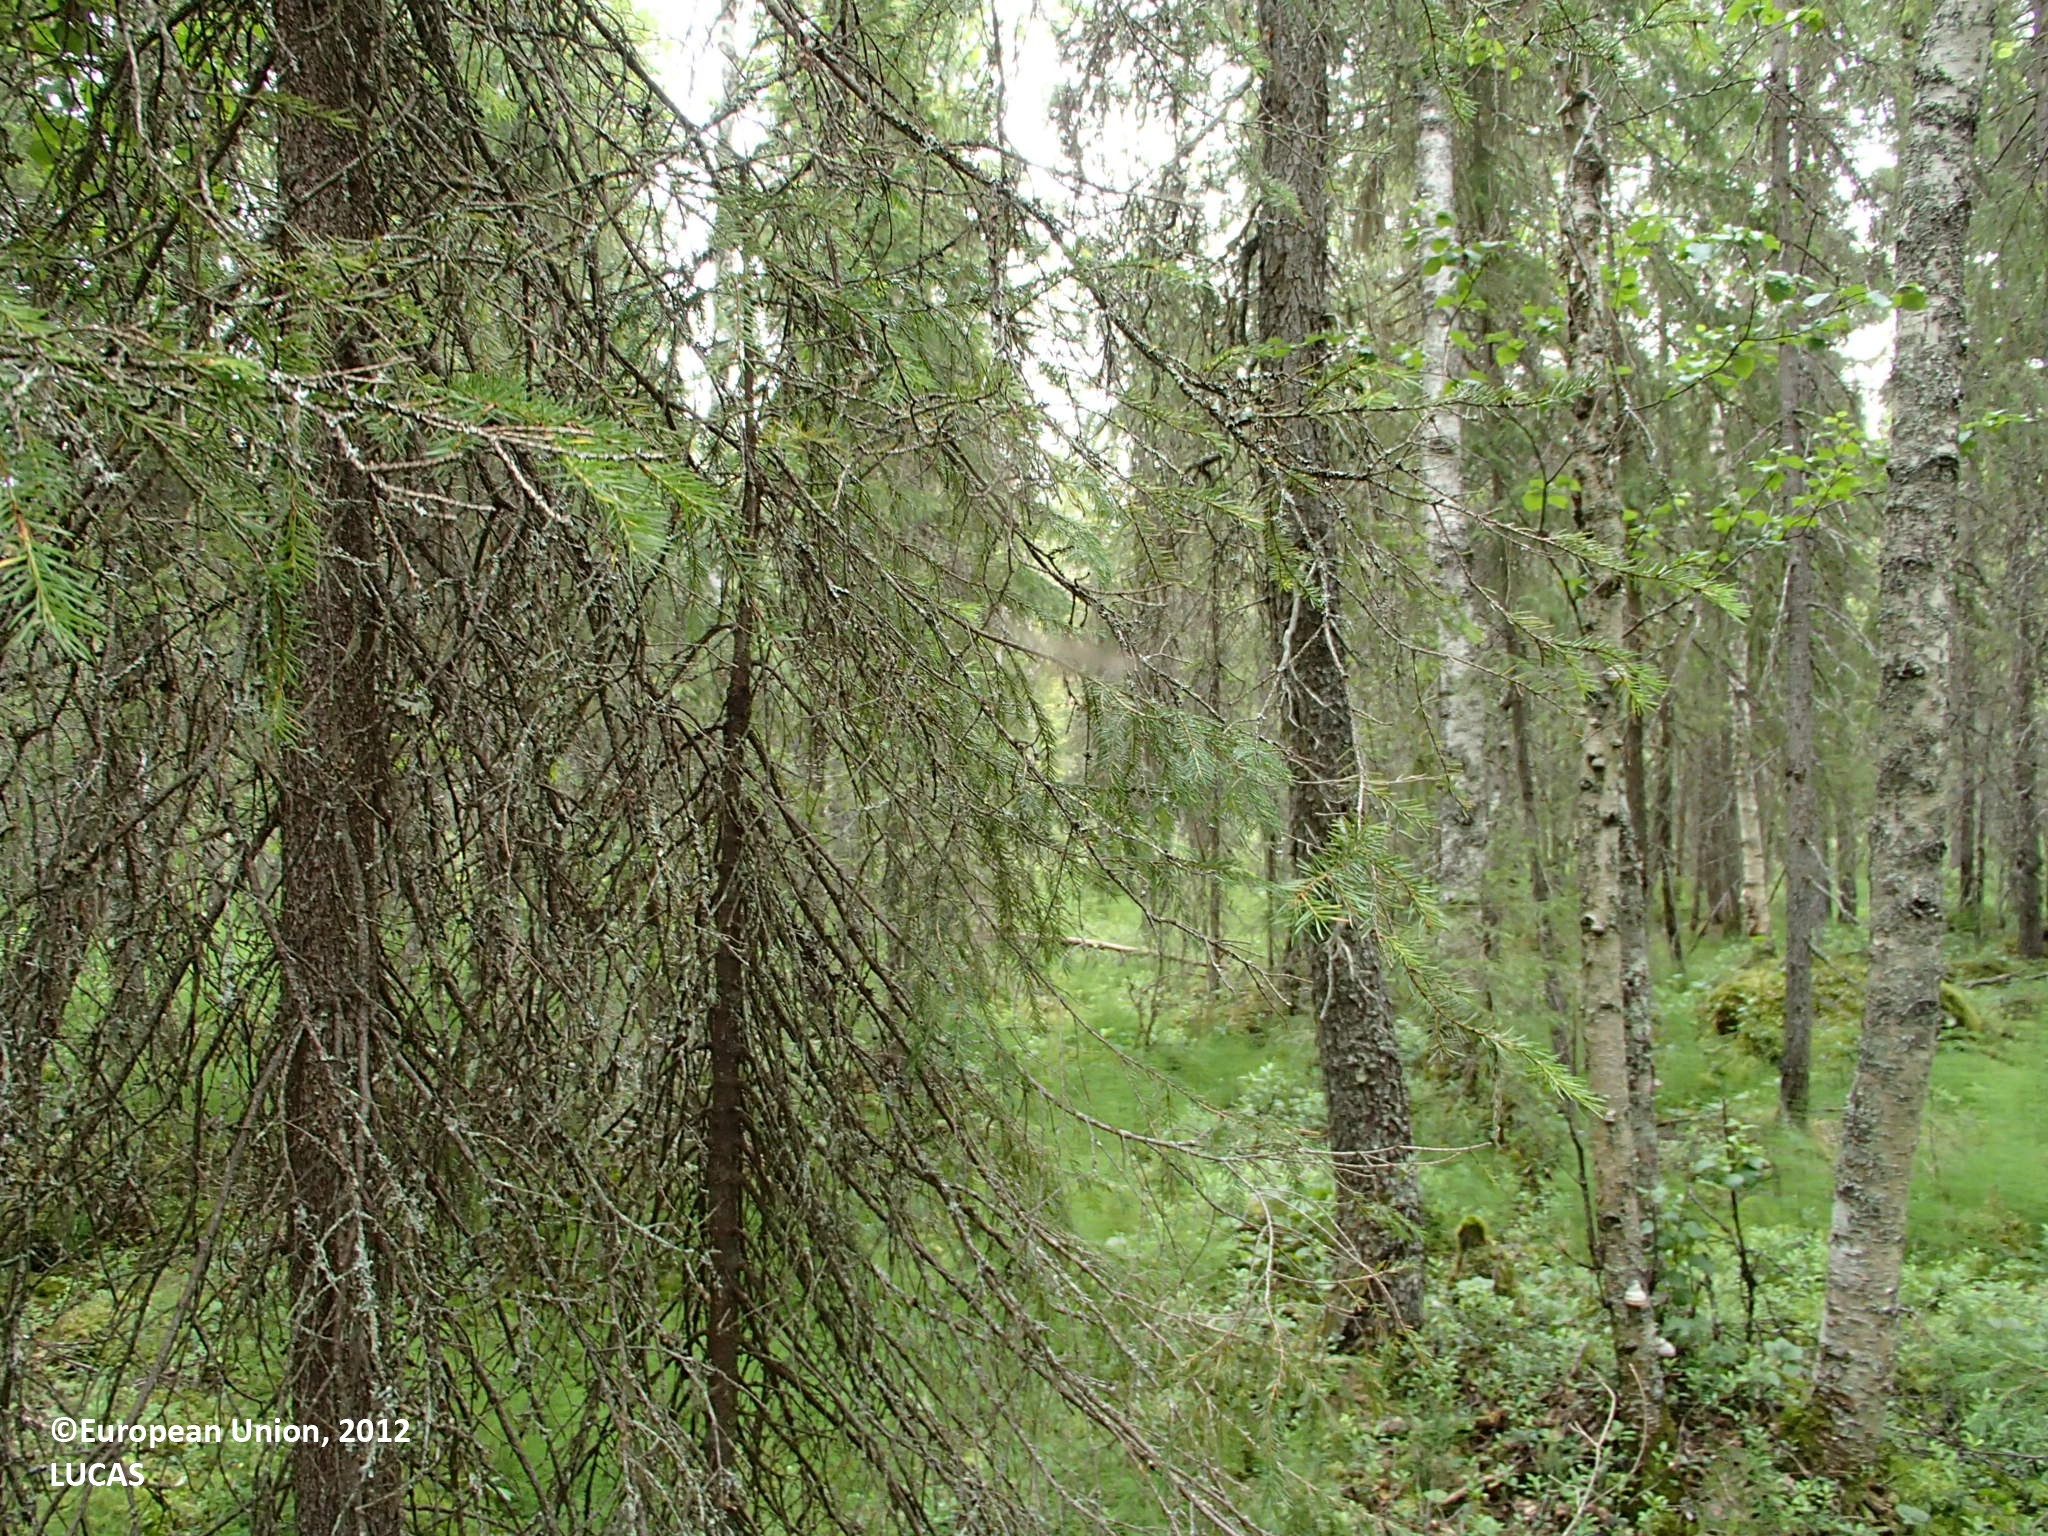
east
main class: Woodland
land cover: Other coniferous woodland
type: boreal forest
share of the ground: > 75 %
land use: Forestry
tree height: > 5 m
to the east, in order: Other coniferous woodland; Broadleaved woodland; Ditches and canals; Tracks; Other mixed woodland; Grassland without tree/shrub cover; Artificial constructions in urban areas; Grassland without tree/shrub cover; Other mixed woodland; Paved roads, cycling and walking lanes; Ditches and canals; Other mixed woodland; Ditches and canals; Paved roads, cycling and walking lanes; Ditches and canals; Other mixed woodland
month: July
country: FI
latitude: 66.4151
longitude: 25.4056
